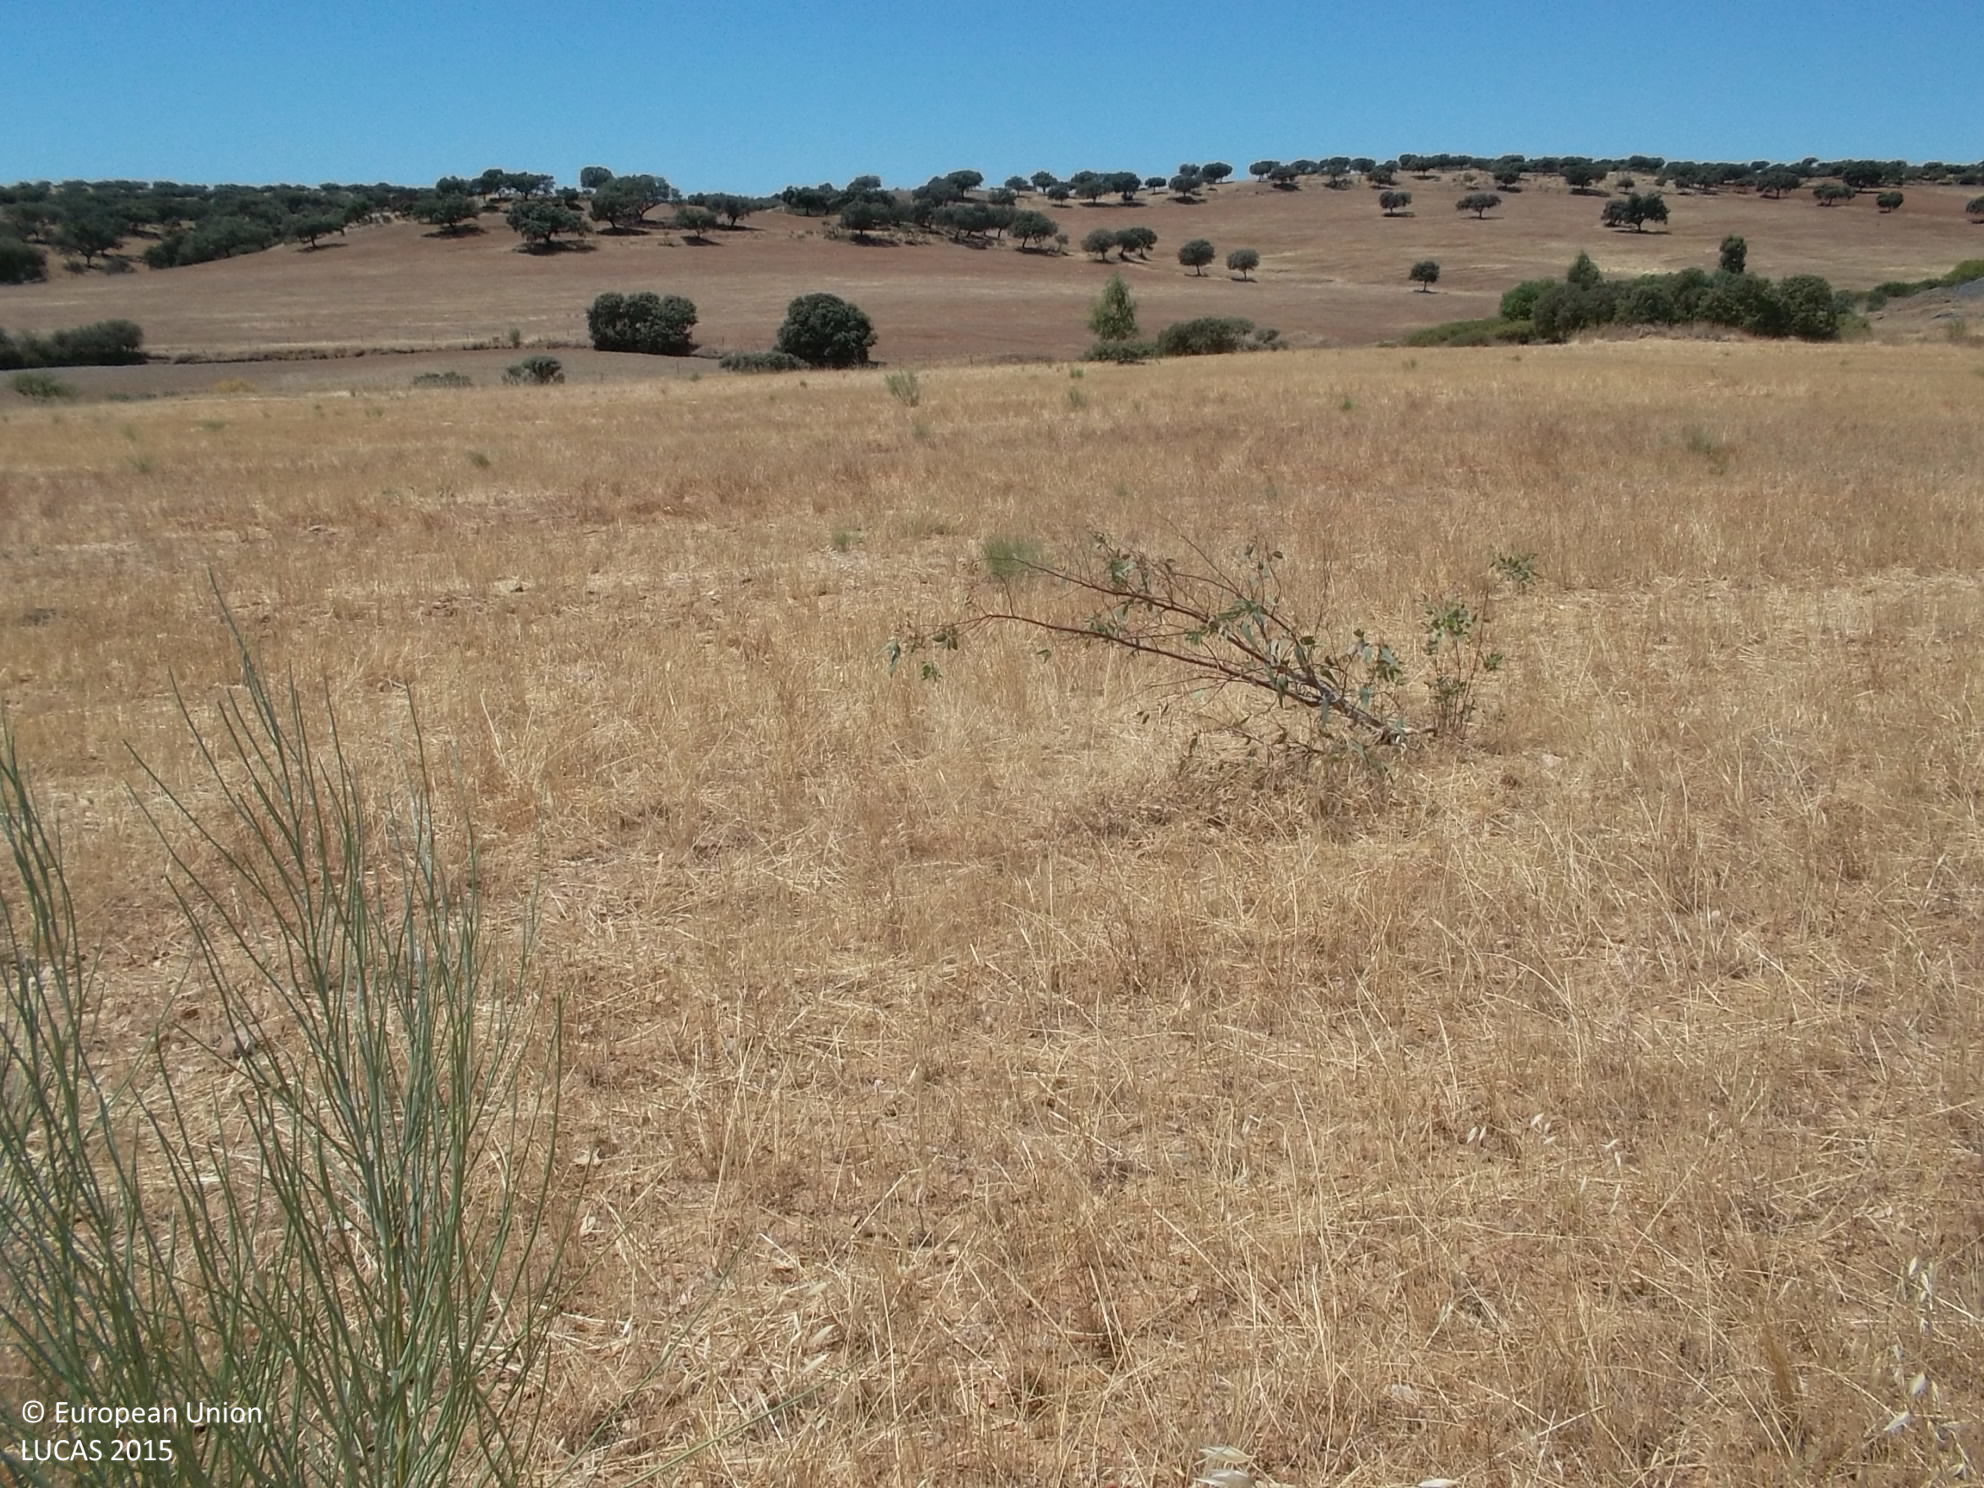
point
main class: Cropland
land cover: Mixed cereals for fodder
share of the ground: < 10 %
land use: Agriculture (excluding fallow land and kitchen gardens)
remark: Harvested field
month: July
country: ES
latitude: 38.2225
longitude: -5.6943
